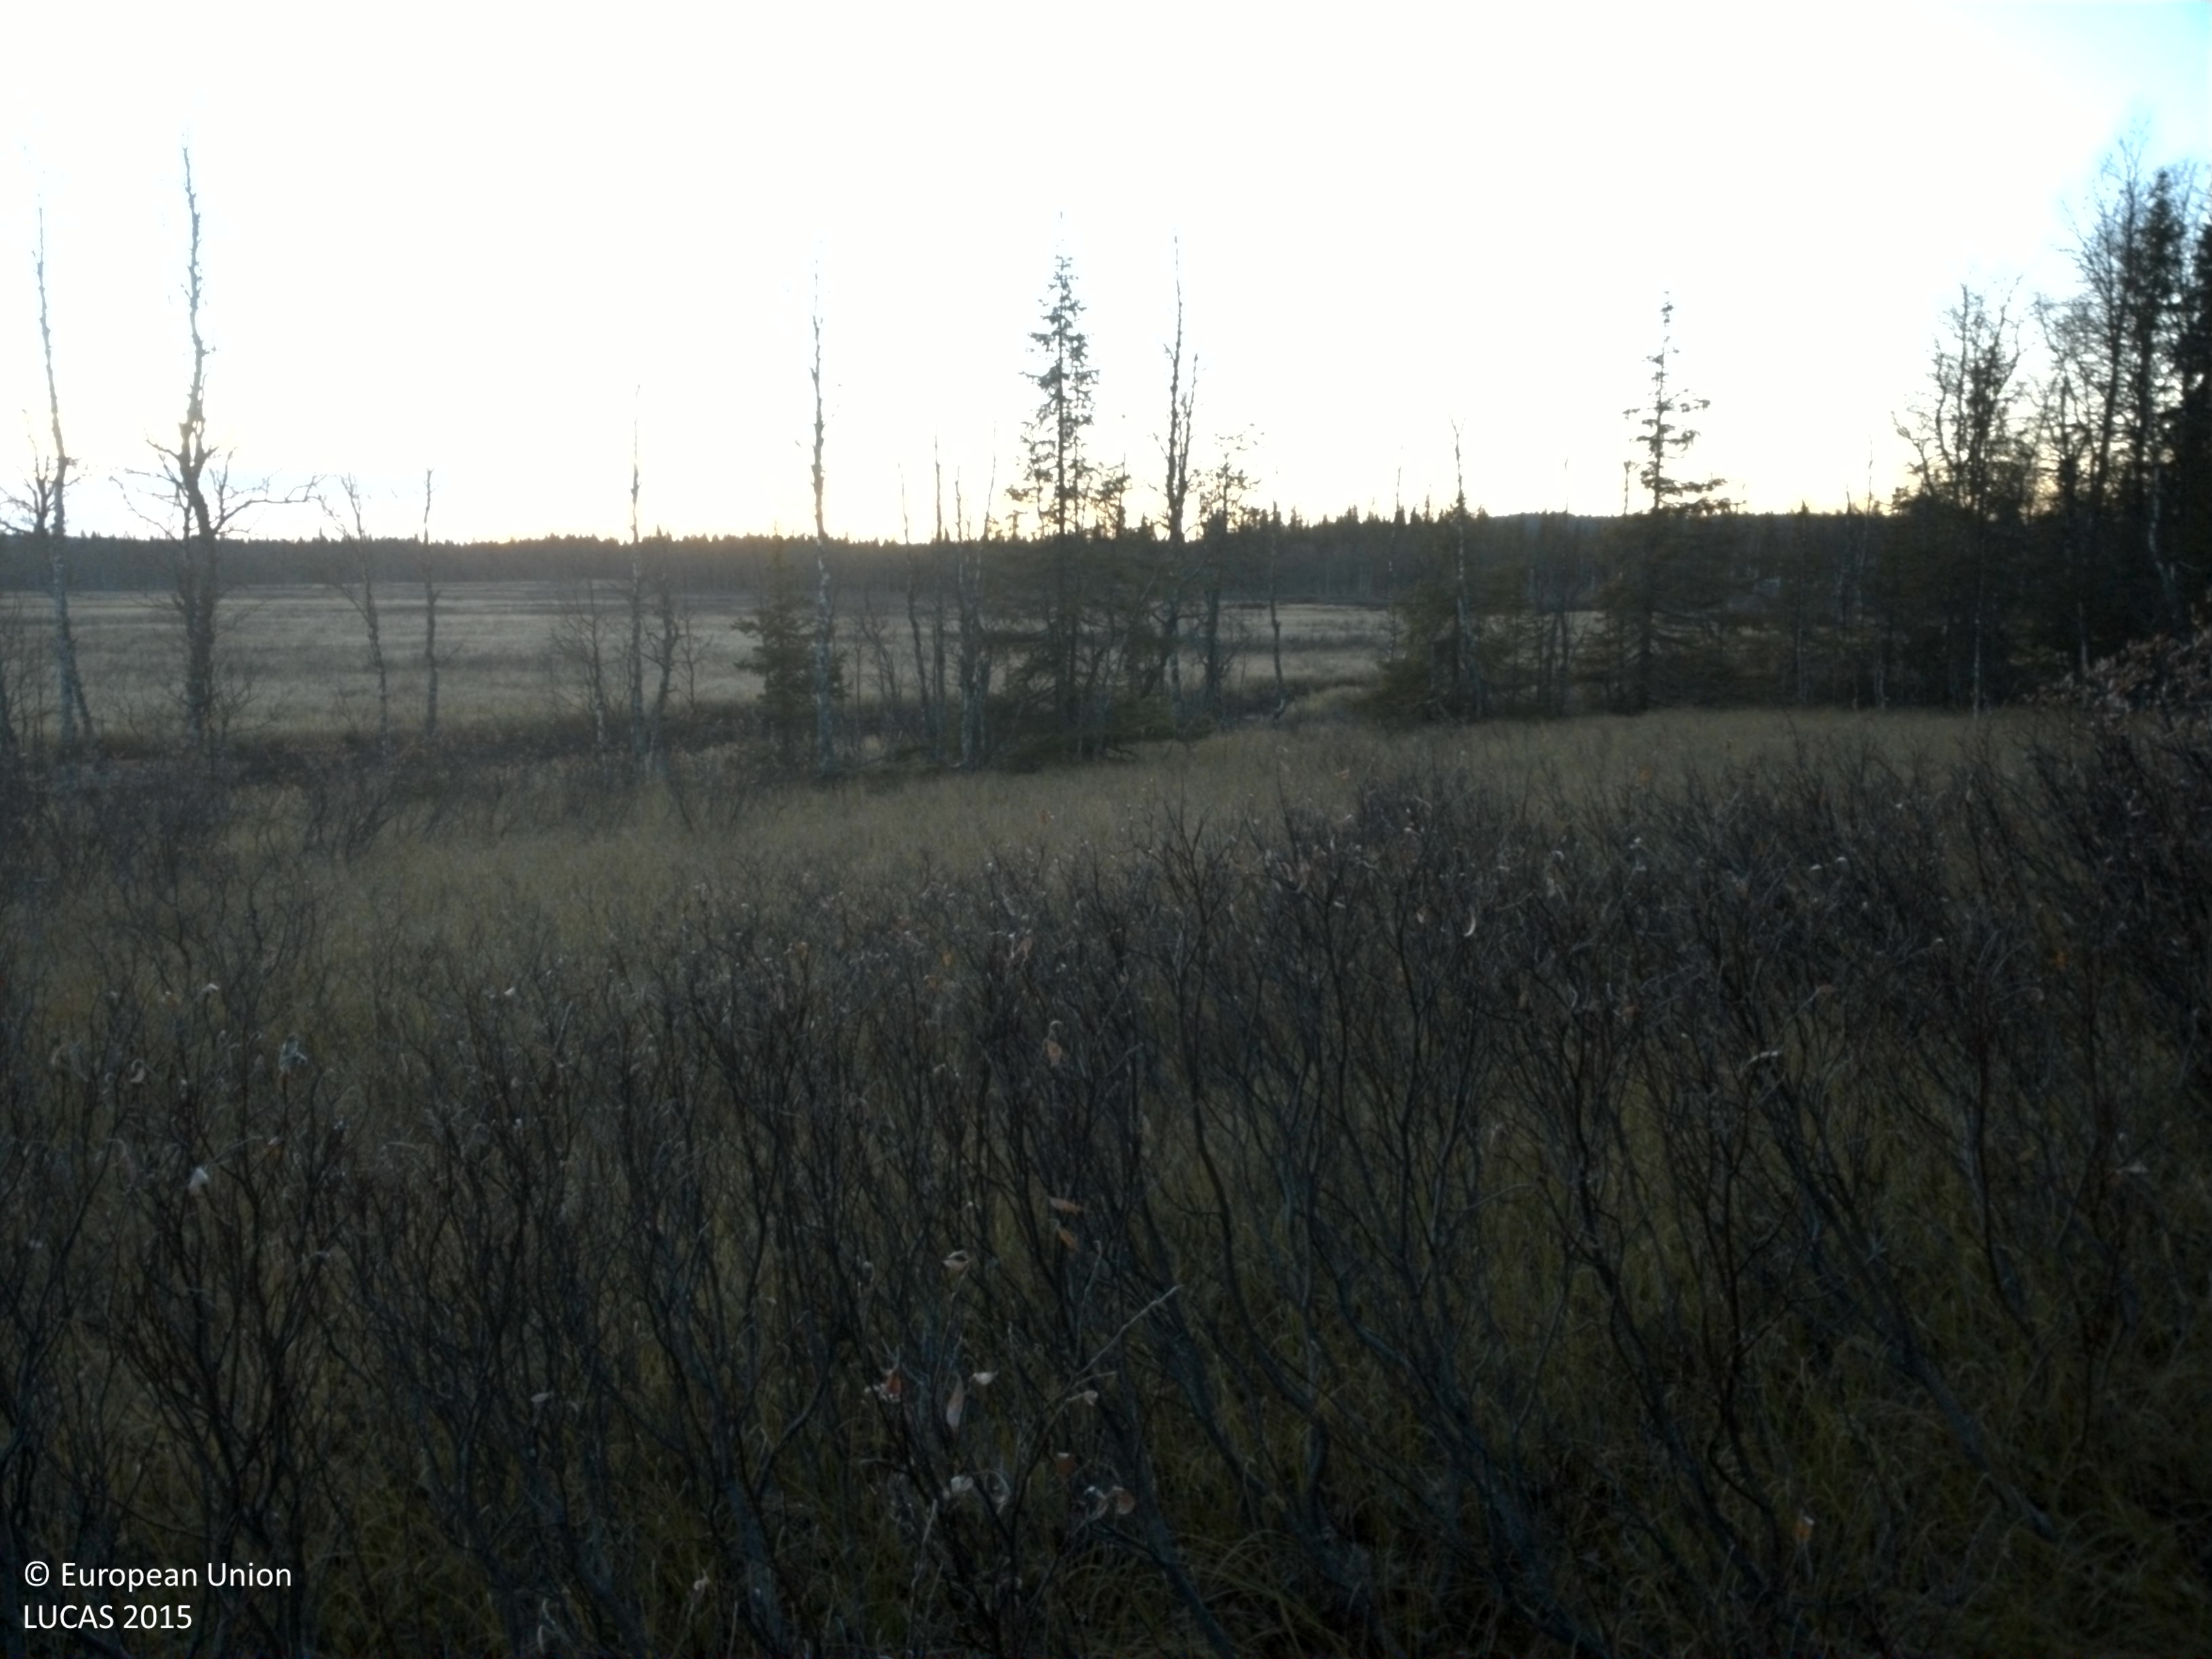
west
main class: Shrubland
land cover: Shrubland without tree cover
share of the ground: 25 - 50 %
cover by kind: herbaceous plants 40 %, shrubs 35 %, lichens and mosses 25 %
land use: Semi-natural and natural areas not in use
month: October
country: SE
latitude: 64.7309
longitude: 17.4610
